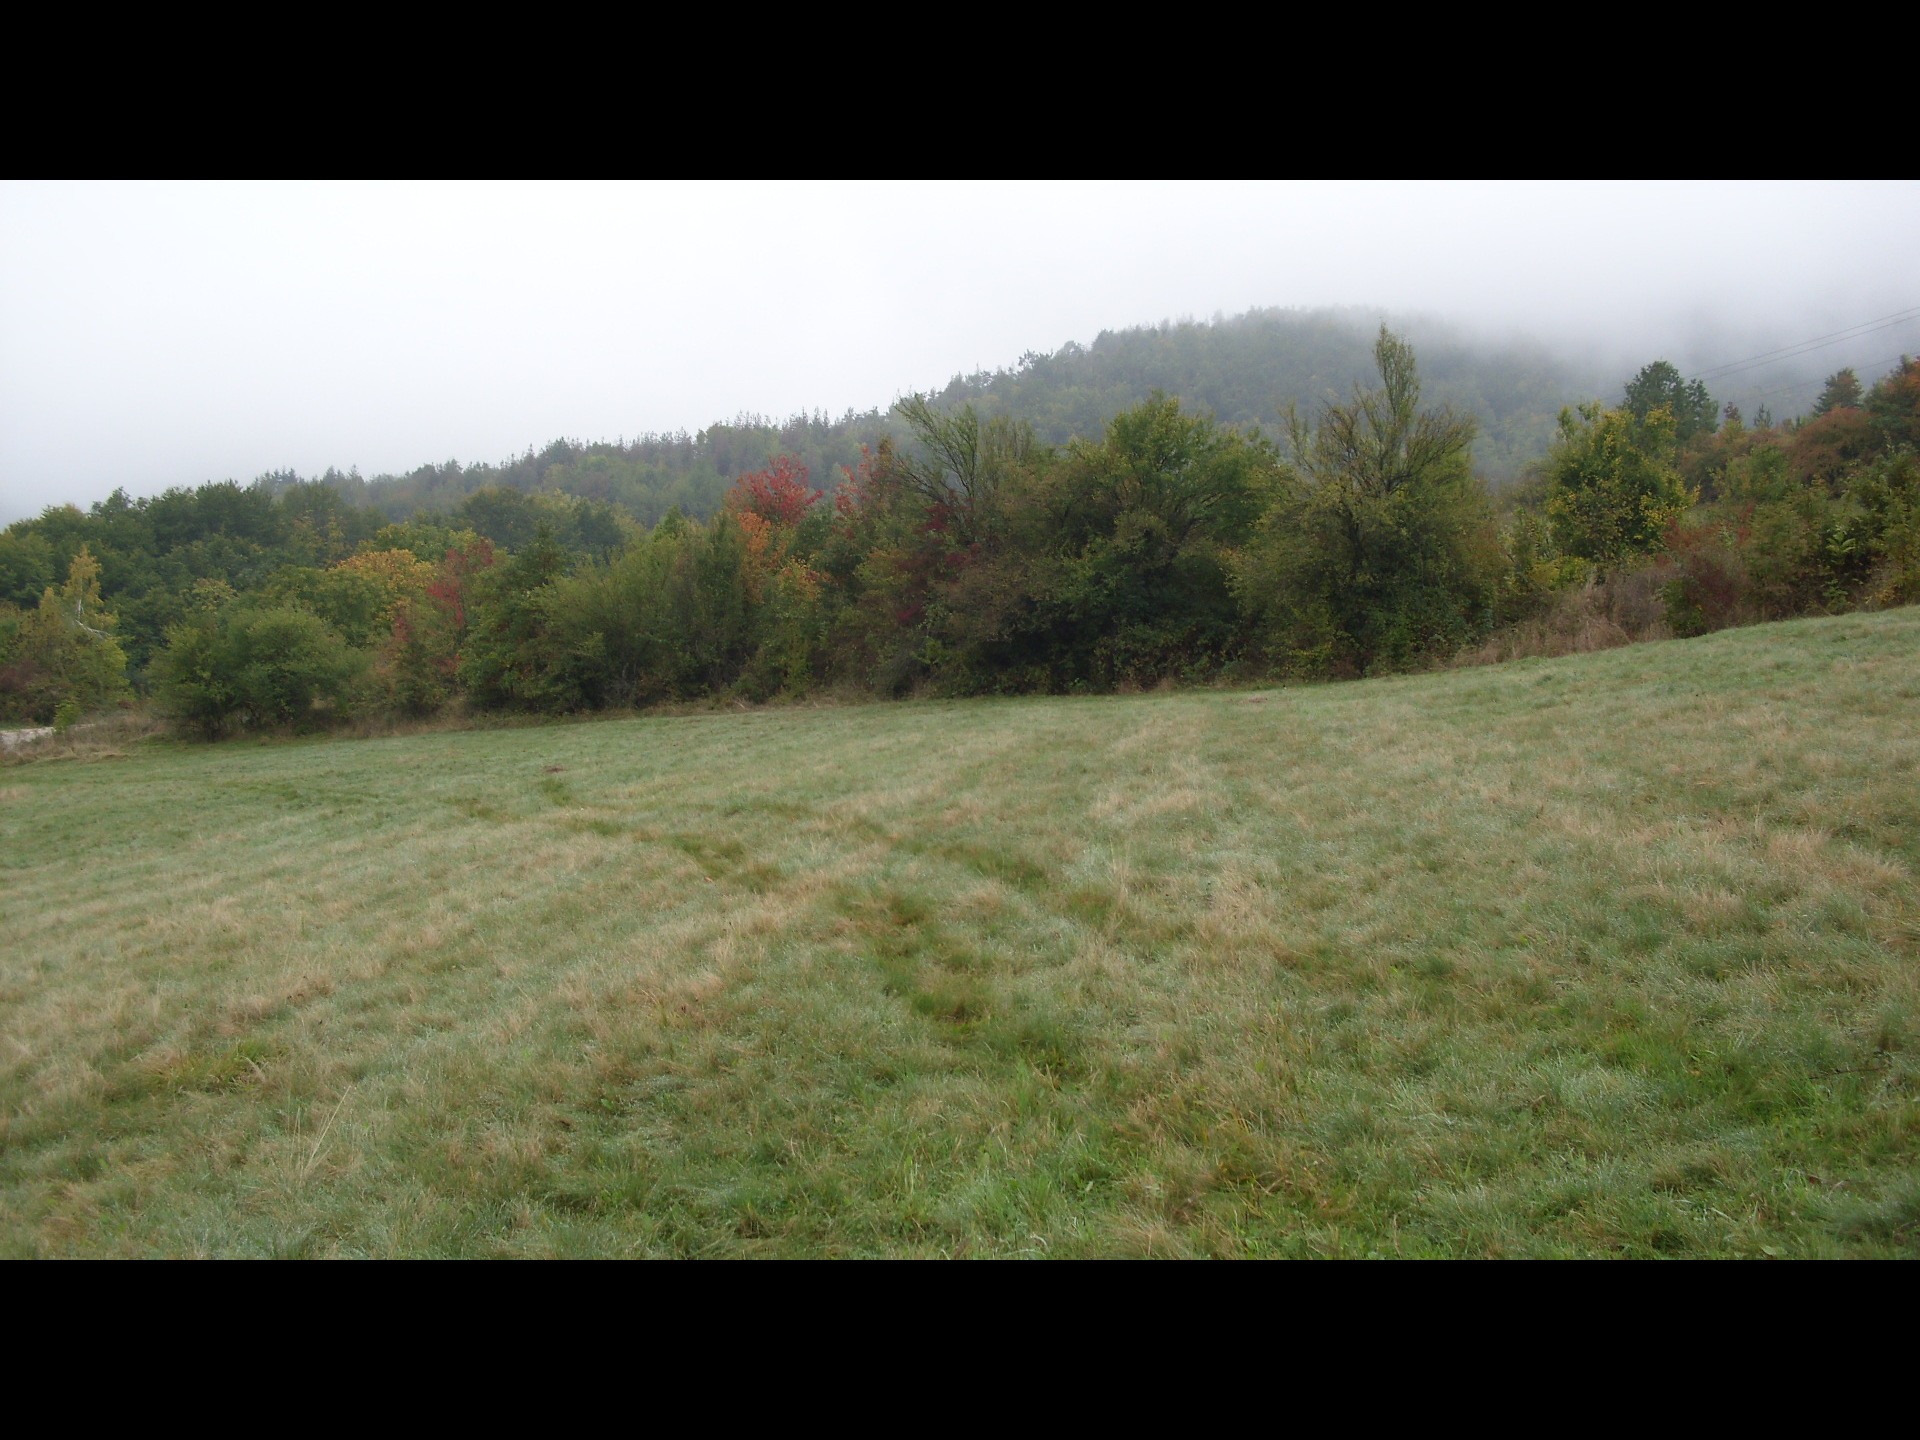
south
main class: Grassland
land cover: Grassland without tree/shrub cover
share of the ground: > 75 %
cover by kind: herbaceous plants 100 %
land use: Agriculture (excluding fallow land and kitchen gardens)
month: October
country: BG
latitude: 43.4542
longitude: 22.7248
